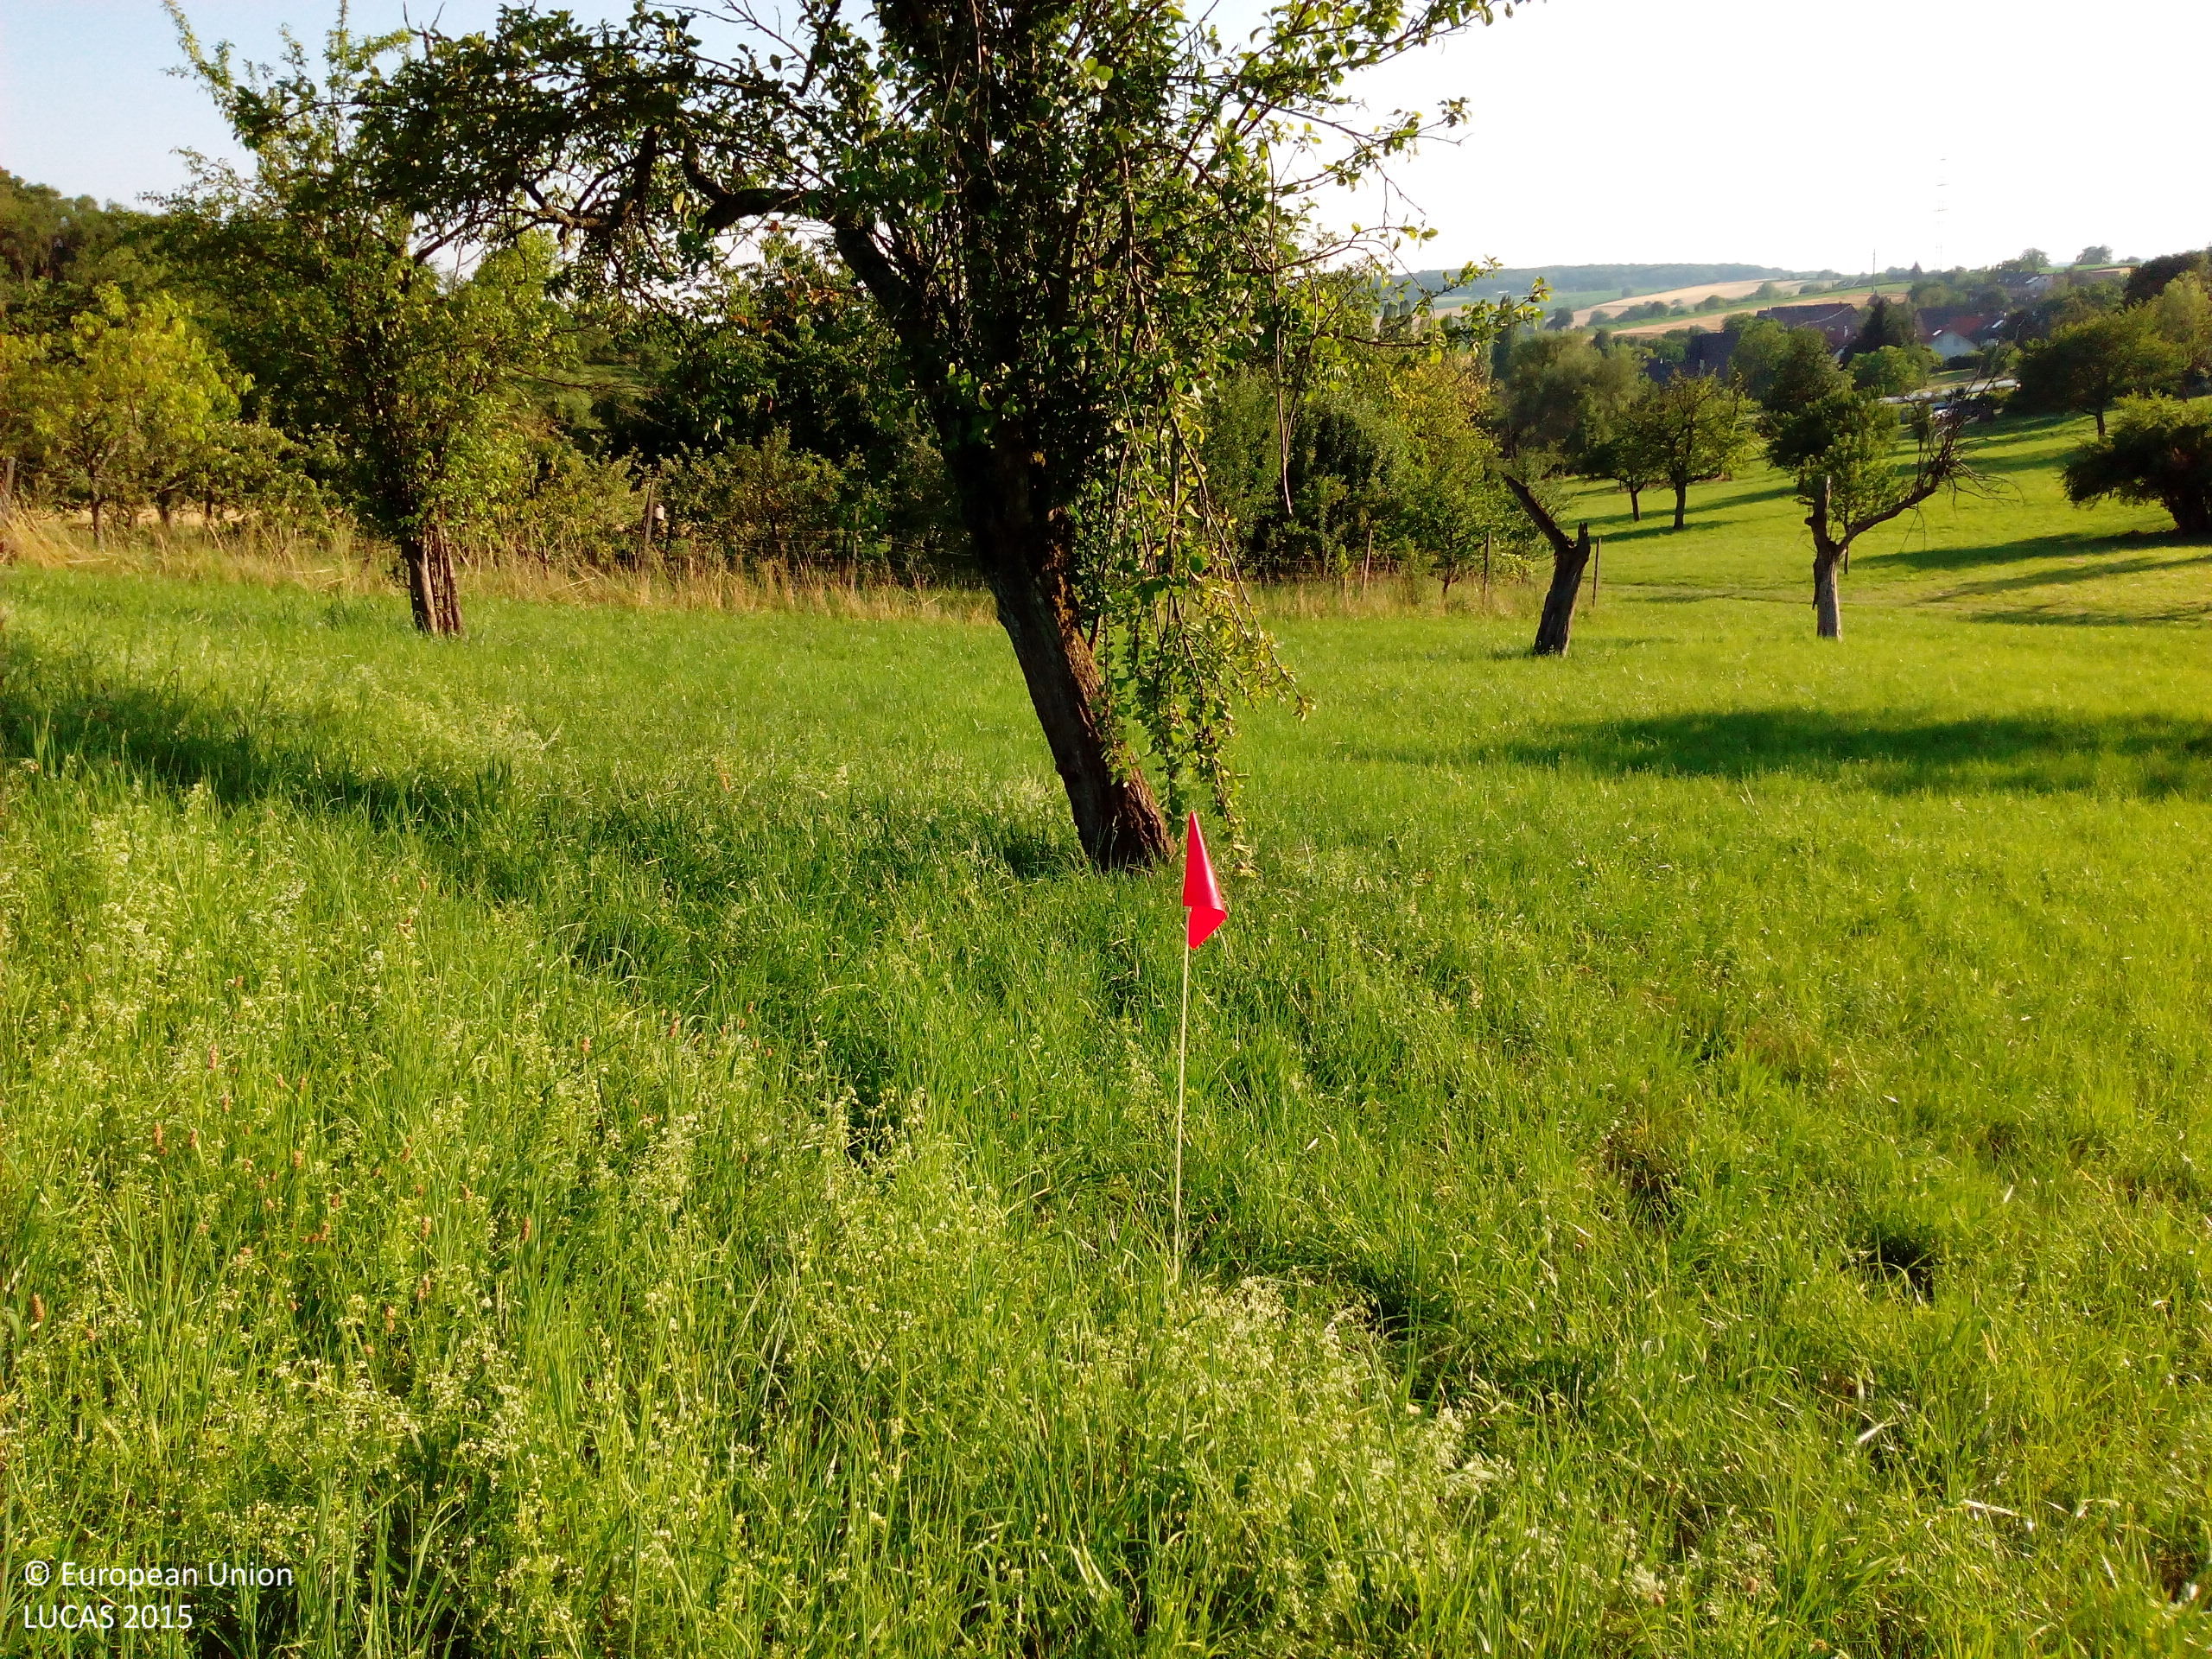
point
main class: Cropland
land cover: Other fruit trees and berries
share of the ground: < 10 %
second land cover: Grassland without tree/shrub cover
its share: > 75 %
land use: Agriculture (excluding fallow land and kitchen gardens)
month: July
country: DE
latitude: 47.7116
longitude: 7.6156
